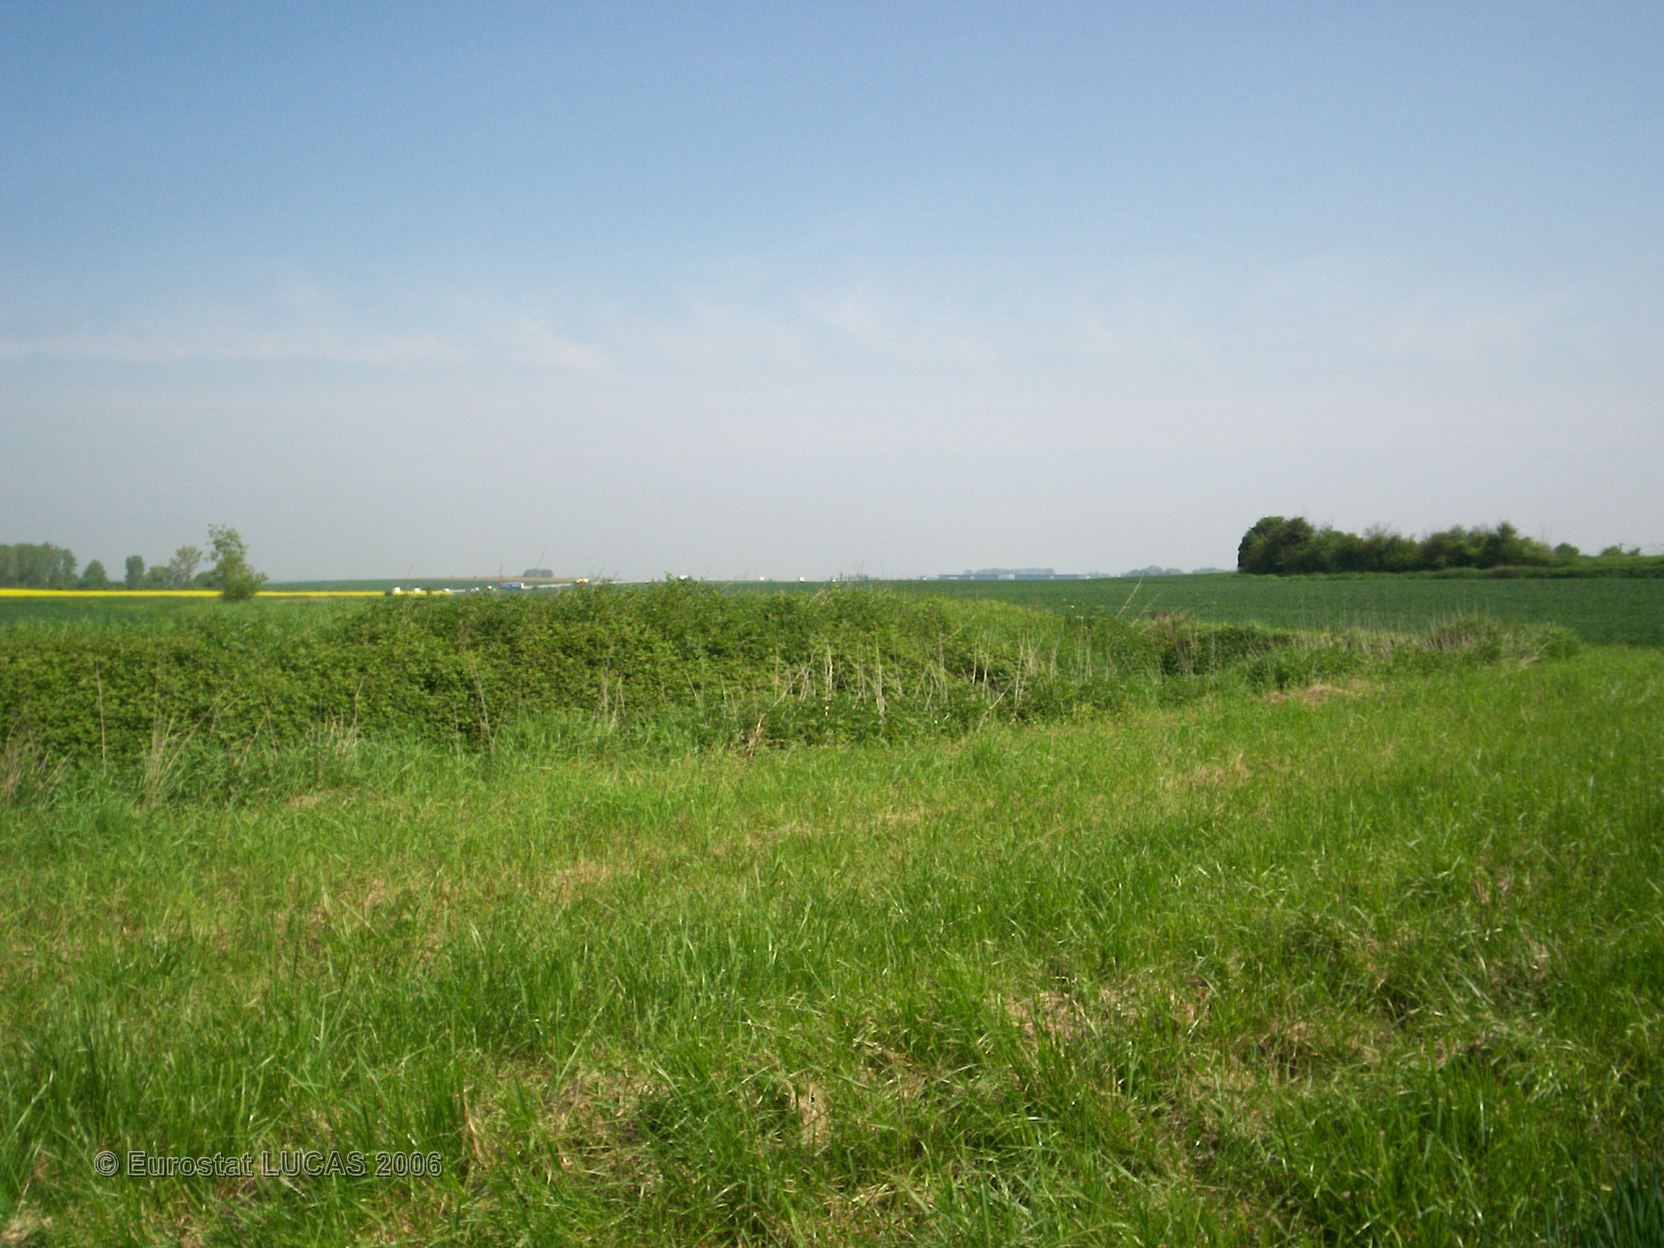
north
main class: Cropland
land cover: Common wheat
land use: Agriculture (excluding fallow land and kitchen gardens)
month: May
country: FR
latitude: 49.0667
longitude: 2.7218
